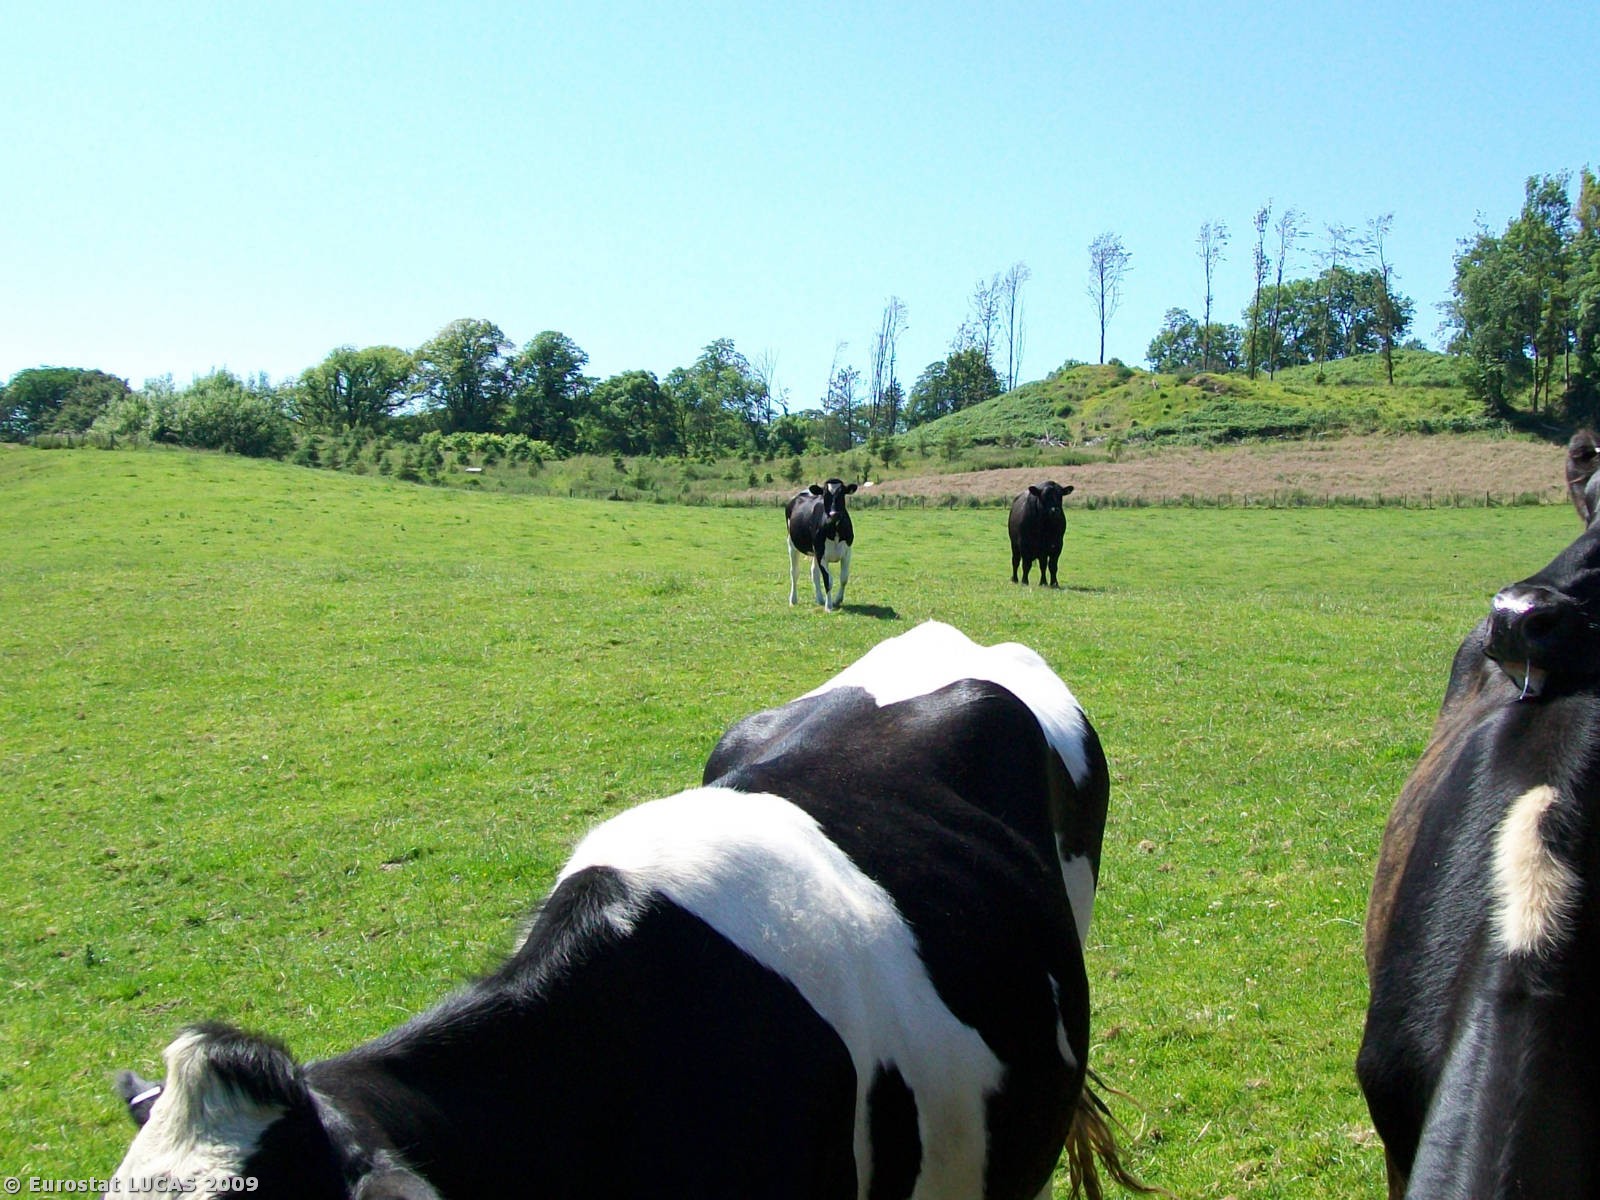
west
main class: Grassland
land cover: Grassland without tree/shrub cover
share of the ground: > 75 %
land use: Agriculture (excluding fallow land and kitchen gardens)
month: June
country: GB
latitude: 54.8274
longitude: -4.0235
